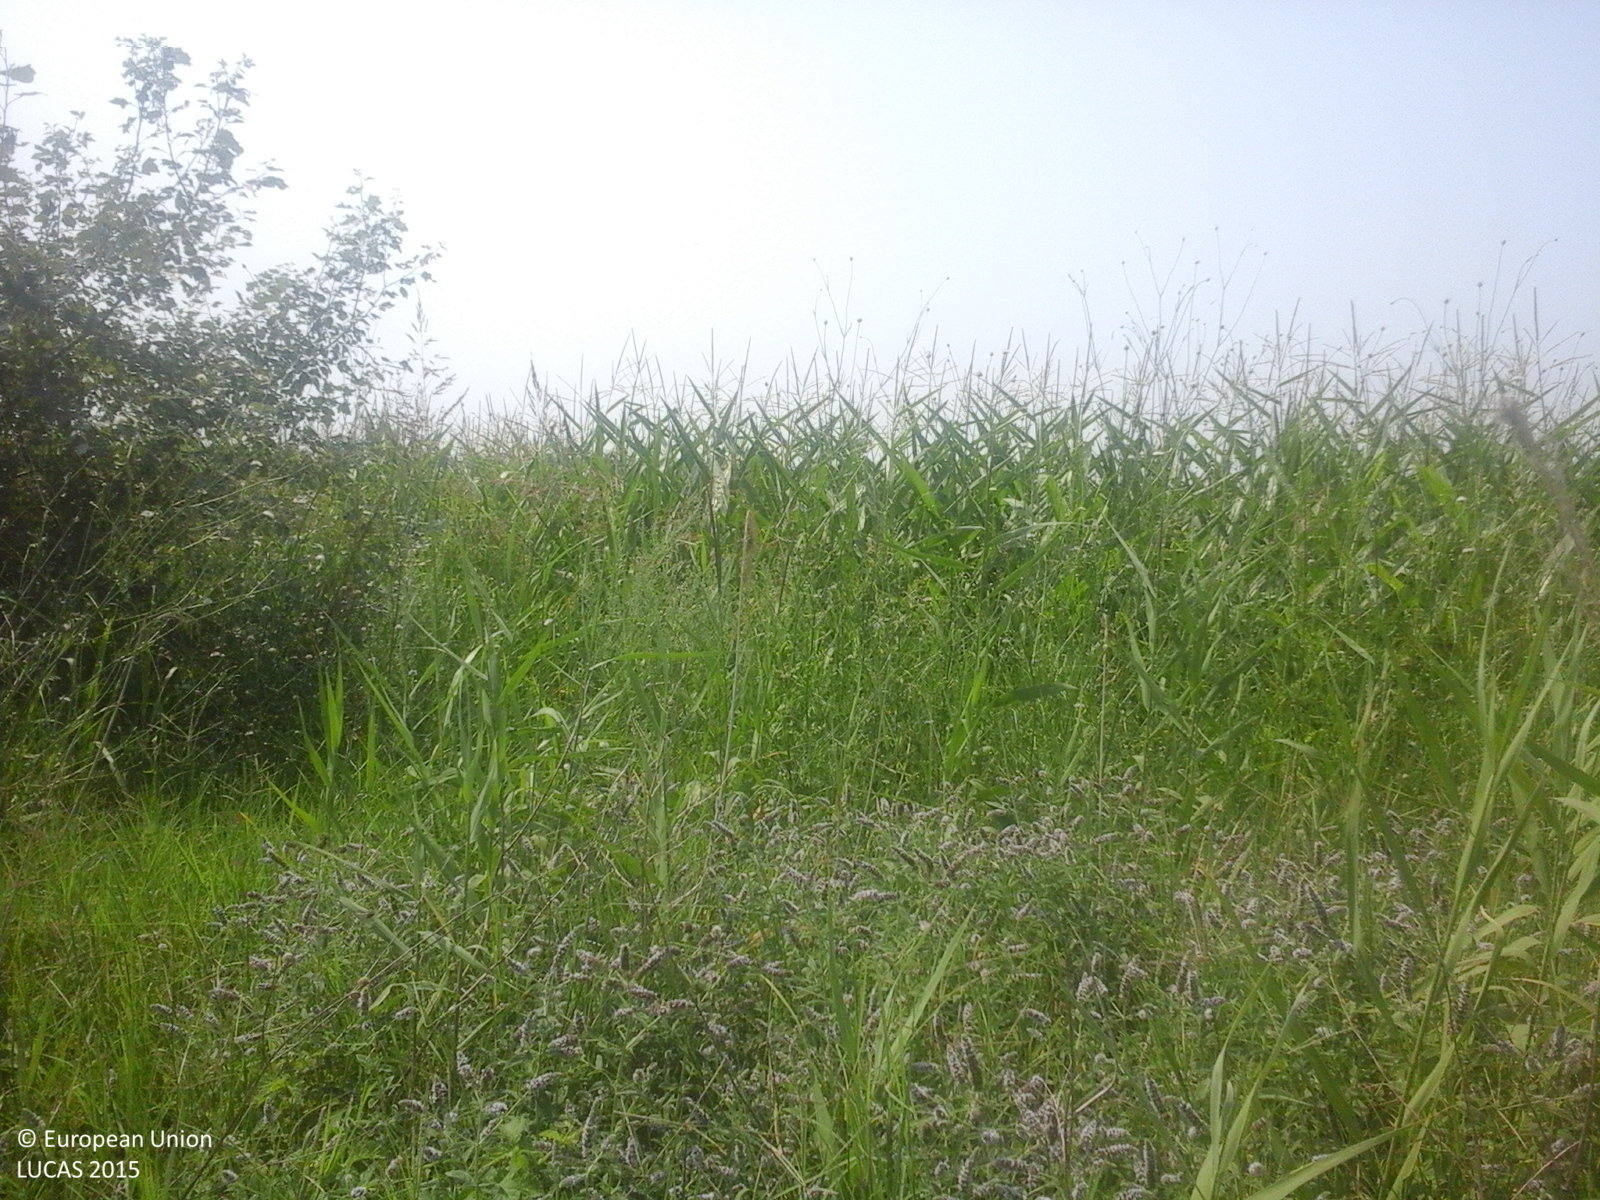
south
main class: Cropland
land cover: Maize
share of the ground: > 75 %
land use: Agriculture (excluding fallow land and kitchen gardens)
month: July
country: RO
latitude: 44.7562
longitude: 26.3212
